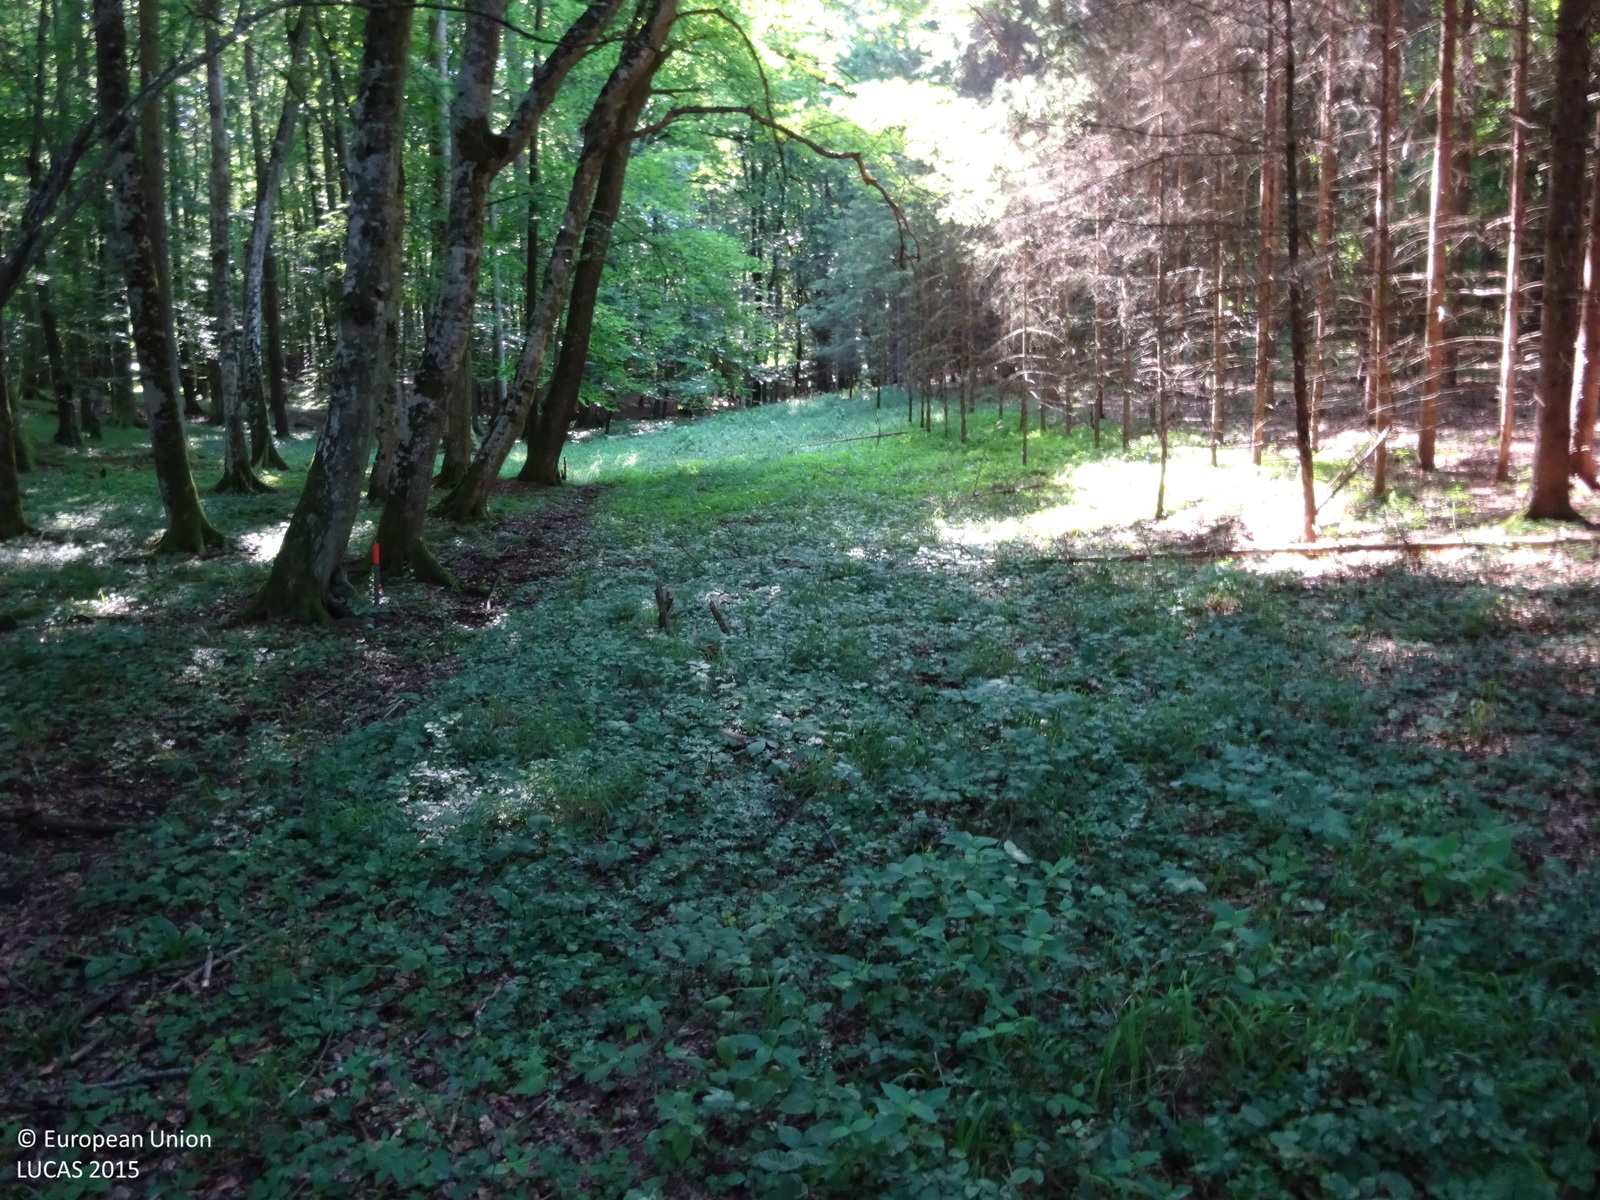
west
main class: Woodland
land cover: Broadleaved woodland
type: mountainous beech forest
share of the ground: > 75 %
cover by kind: broadleaved forest trees 85 %, coniferous forest trees 10 %, herbaceous plants 5 %
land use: Forestry
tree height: > 5 m
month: June
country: AT
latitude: 46.7974
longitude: 15.9880
